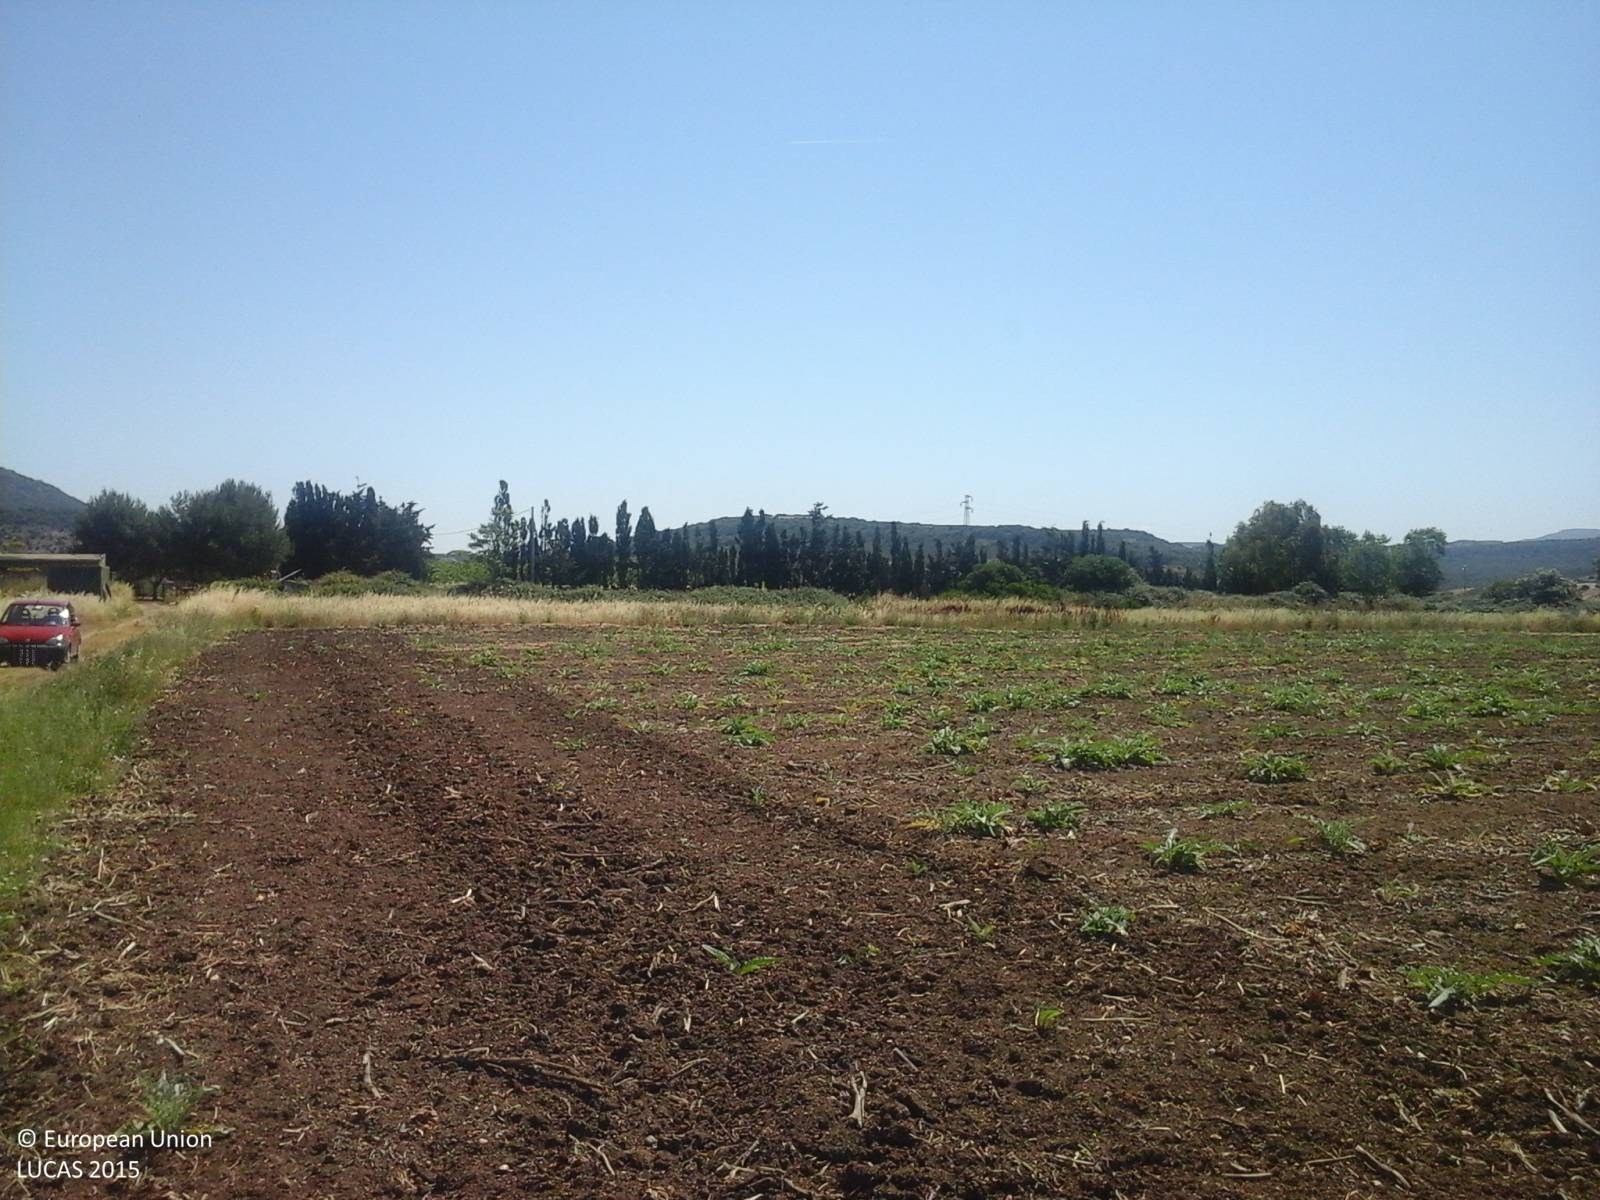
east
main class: Cropland
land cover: Other fresh vegetables
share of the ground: < 10 %
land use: Agriculture (excluding fallow land and kitchen gardens)
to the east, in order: Tracks; Other fresh vegetables; Grassland without tree/shrub cover; Abandoned hedges; Dry stone walls; Other fruit trees and berries; Dry stone walls; Managed hedges; Grass margins; Paved roads, cycling and walking lanes
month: June
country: IT
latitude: 40.6161
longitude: 8.3885
